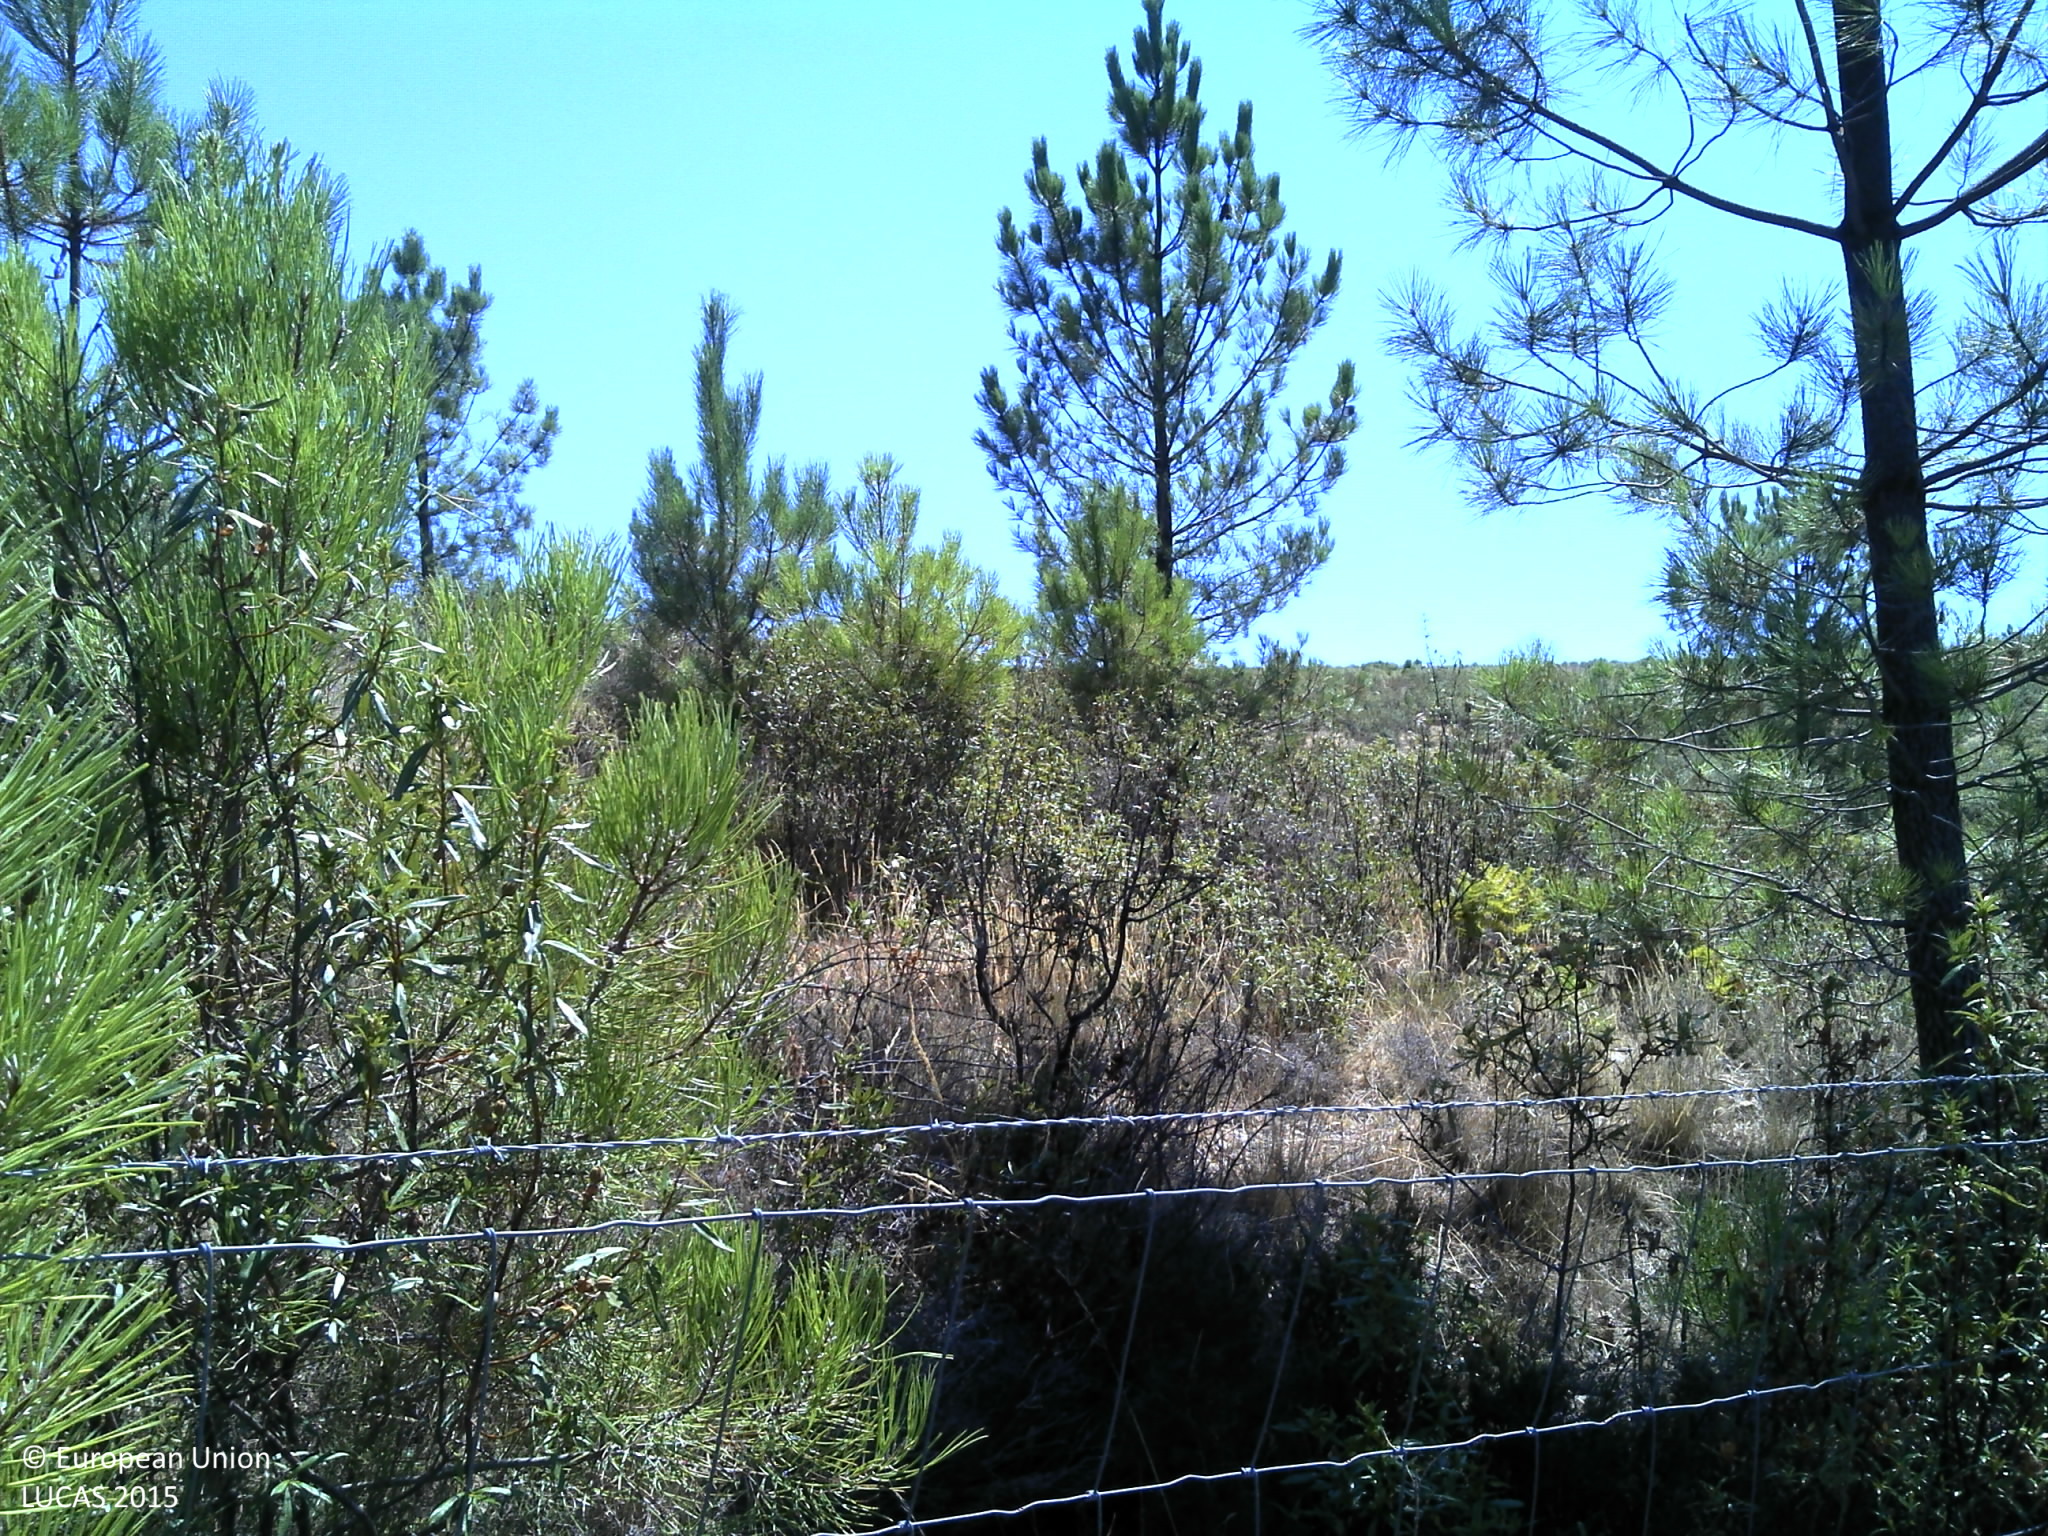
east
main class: Woodland
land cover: Pine dominated coniferous woodland
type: coniferous forest of the mediterranean region
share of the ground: 10 - 25 %
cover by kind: shrubs 85 %, coniferous forest trees 15 %
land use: Forestry
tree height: > 5 m
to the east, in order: Shruby margins; Fences; Pine dominated coniferous woodland; Shrubland without tree cover; Spontaneously vegetated surfaces; Fences; Pine dominated coniferous woodland
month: August
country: PT
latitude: 39.3119
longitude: -7.3792
